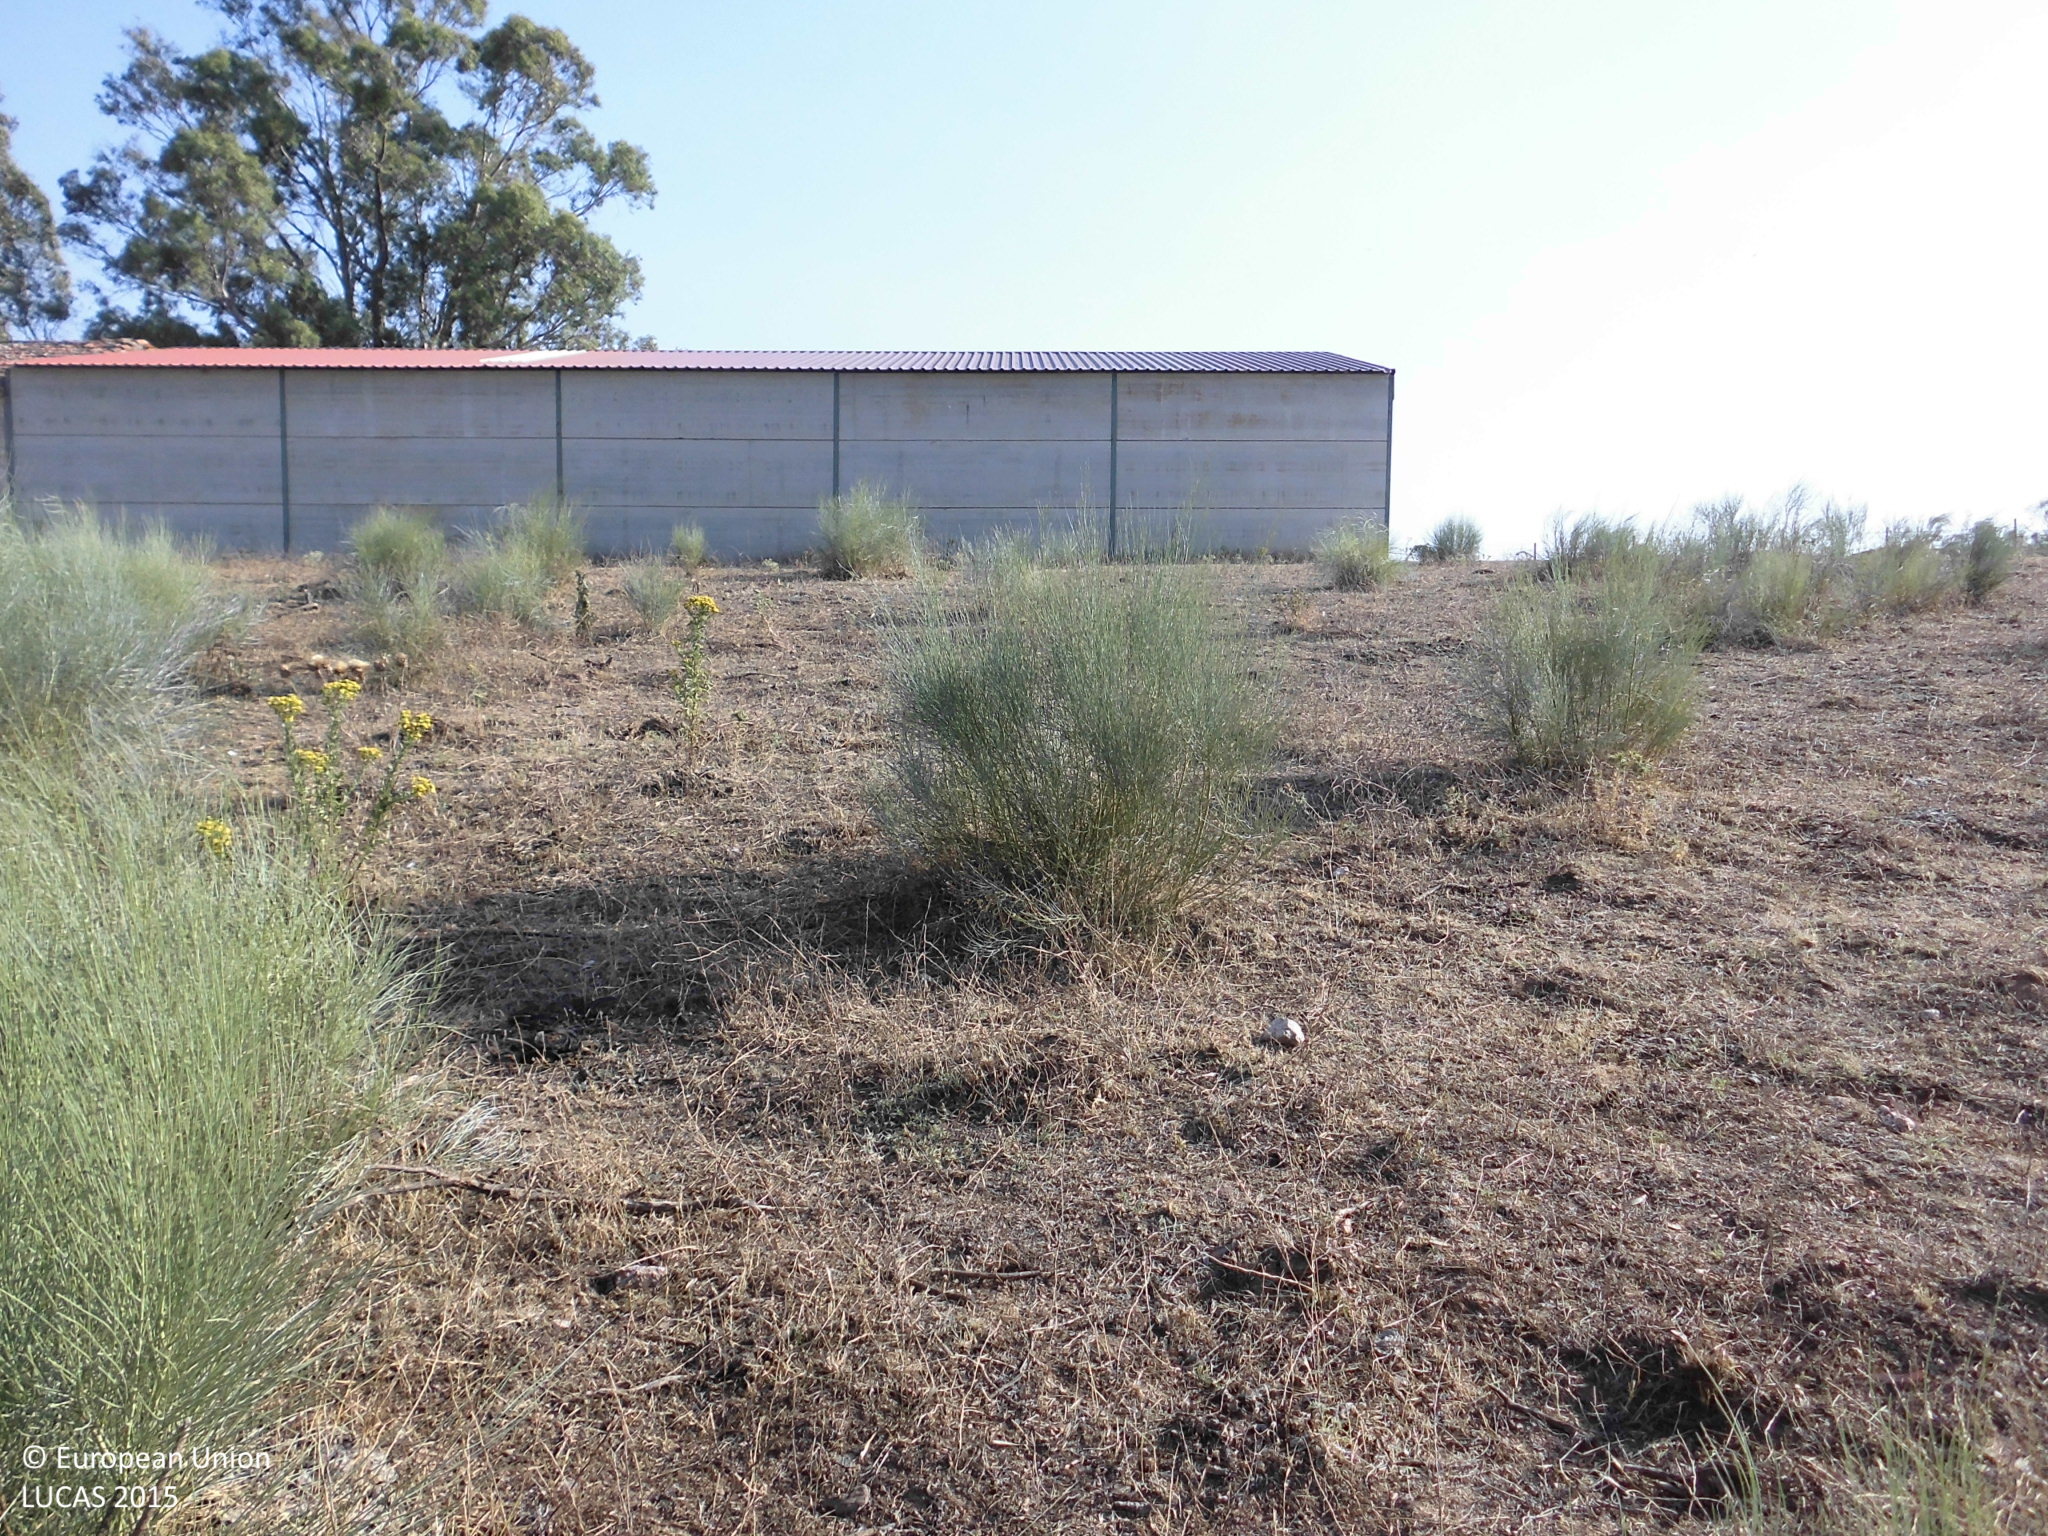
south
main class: Shrubland
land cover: Shrubland without tree cover
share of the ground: 10 - 25 %
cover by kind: herbaceous plants 70 %, shrubs 25 %, unconsolidated bare surface 5 %
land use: Agriculture (excluding fallow land and kitchen gardens)
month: June
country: ES
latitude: 39.9567
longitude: -6.0002
